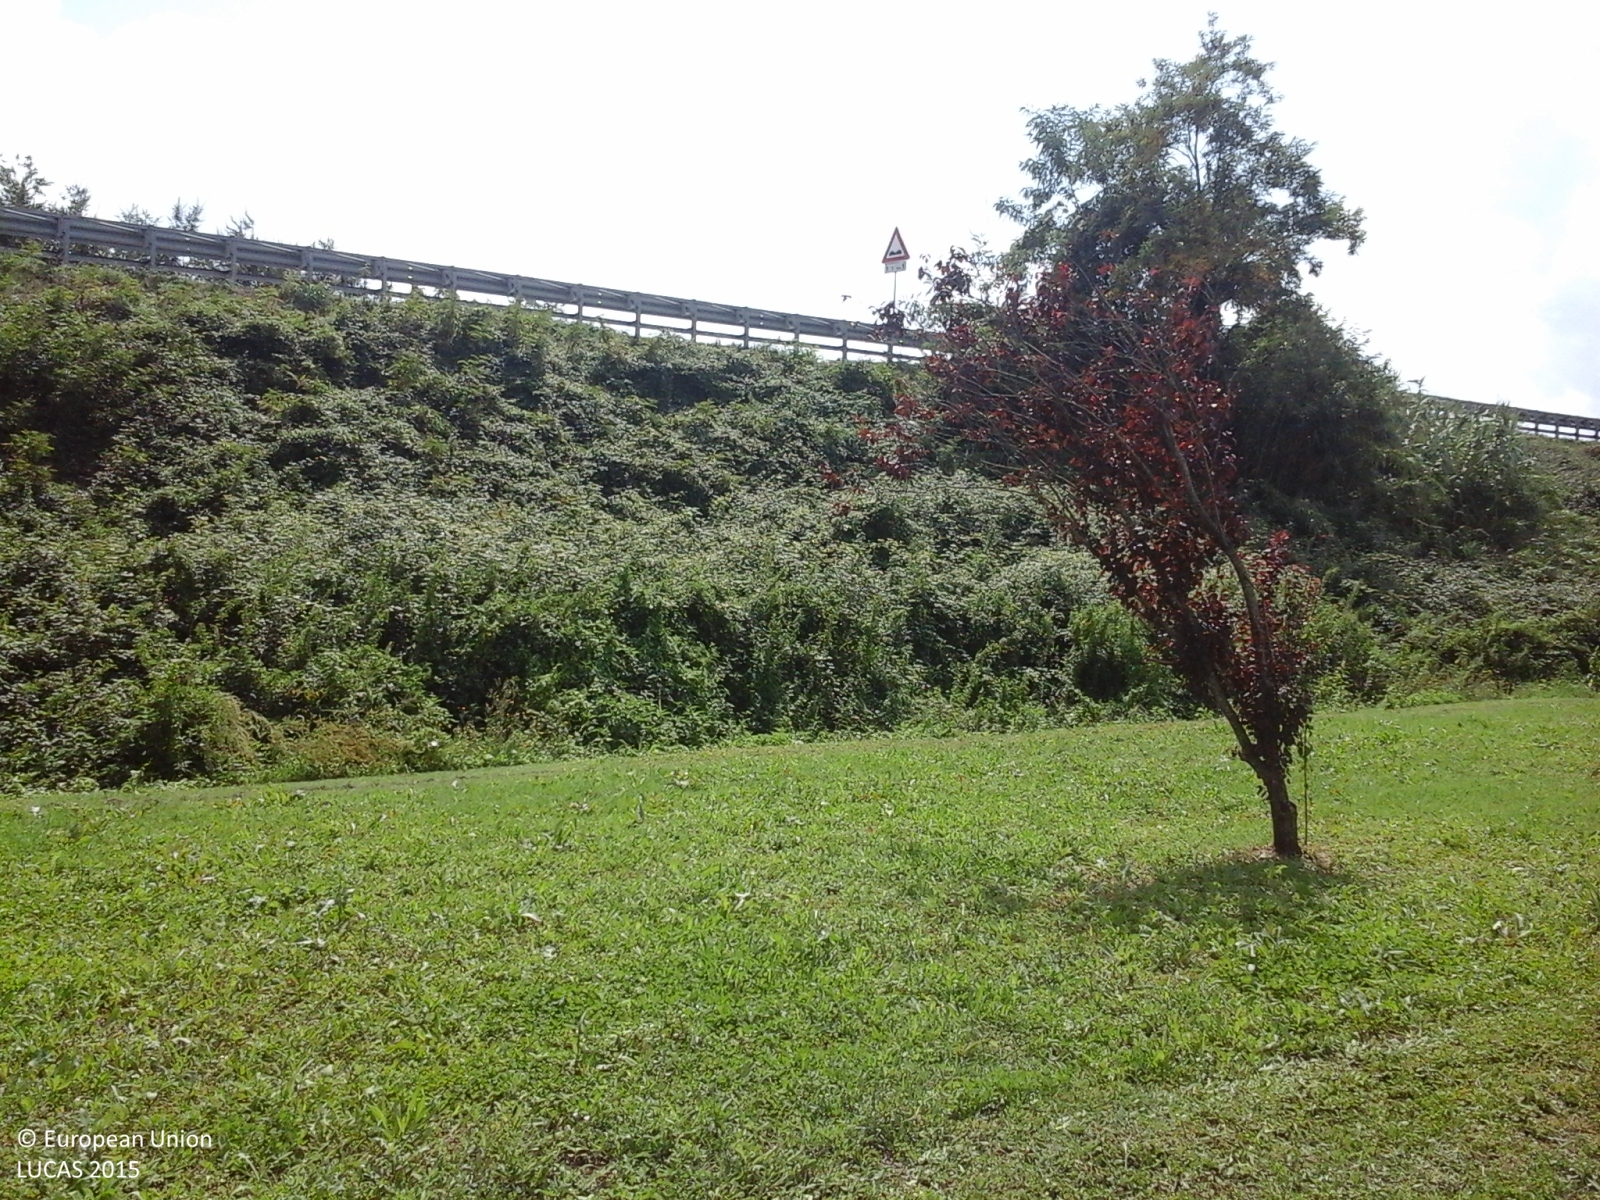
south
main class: Grassland
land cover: Grassland without tree/shrub cover
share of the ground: > 75 %
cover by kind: herbaceous plants 100 %
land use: Community services
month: August
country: IT
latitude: 43.4882
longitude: 13.2193
